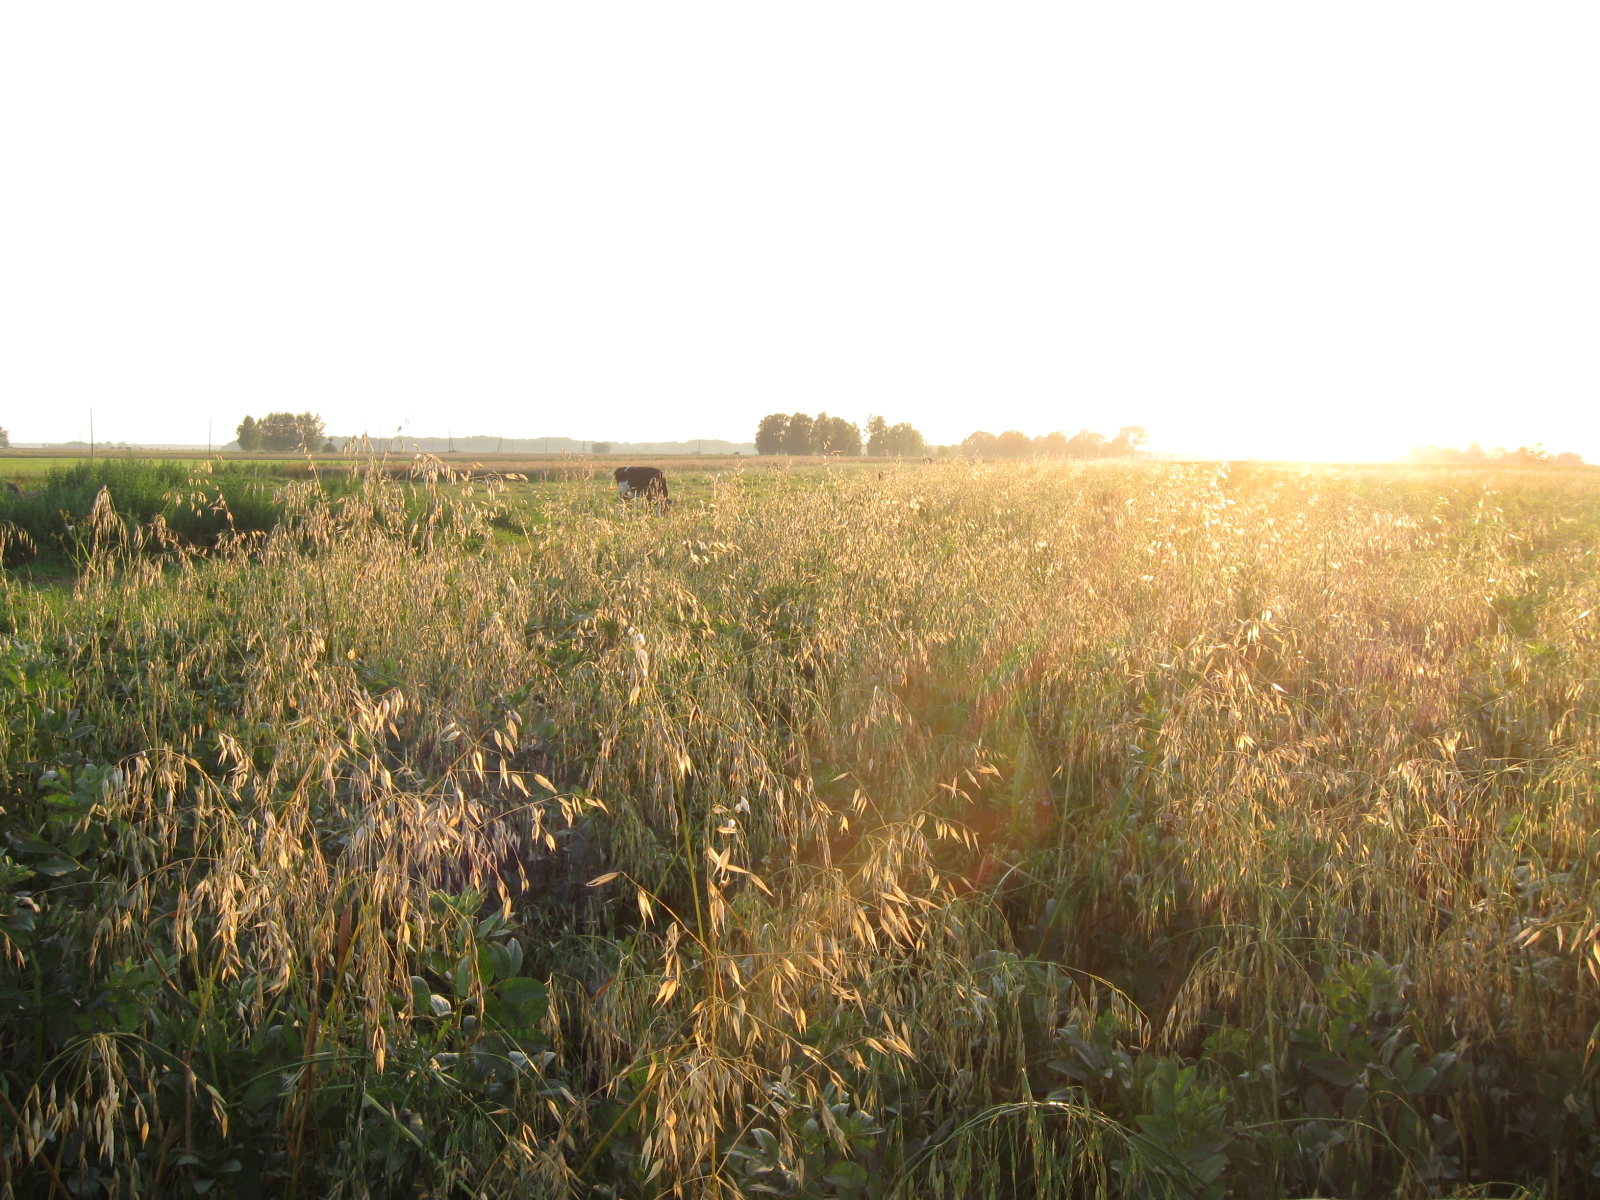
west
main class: Cropland
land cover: Dry pulses
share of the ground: > 75 %
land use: Agriculture (excluding fallow land and kitchen gardens)
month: August
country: LT
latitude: 55.0132
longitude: 23.1633
